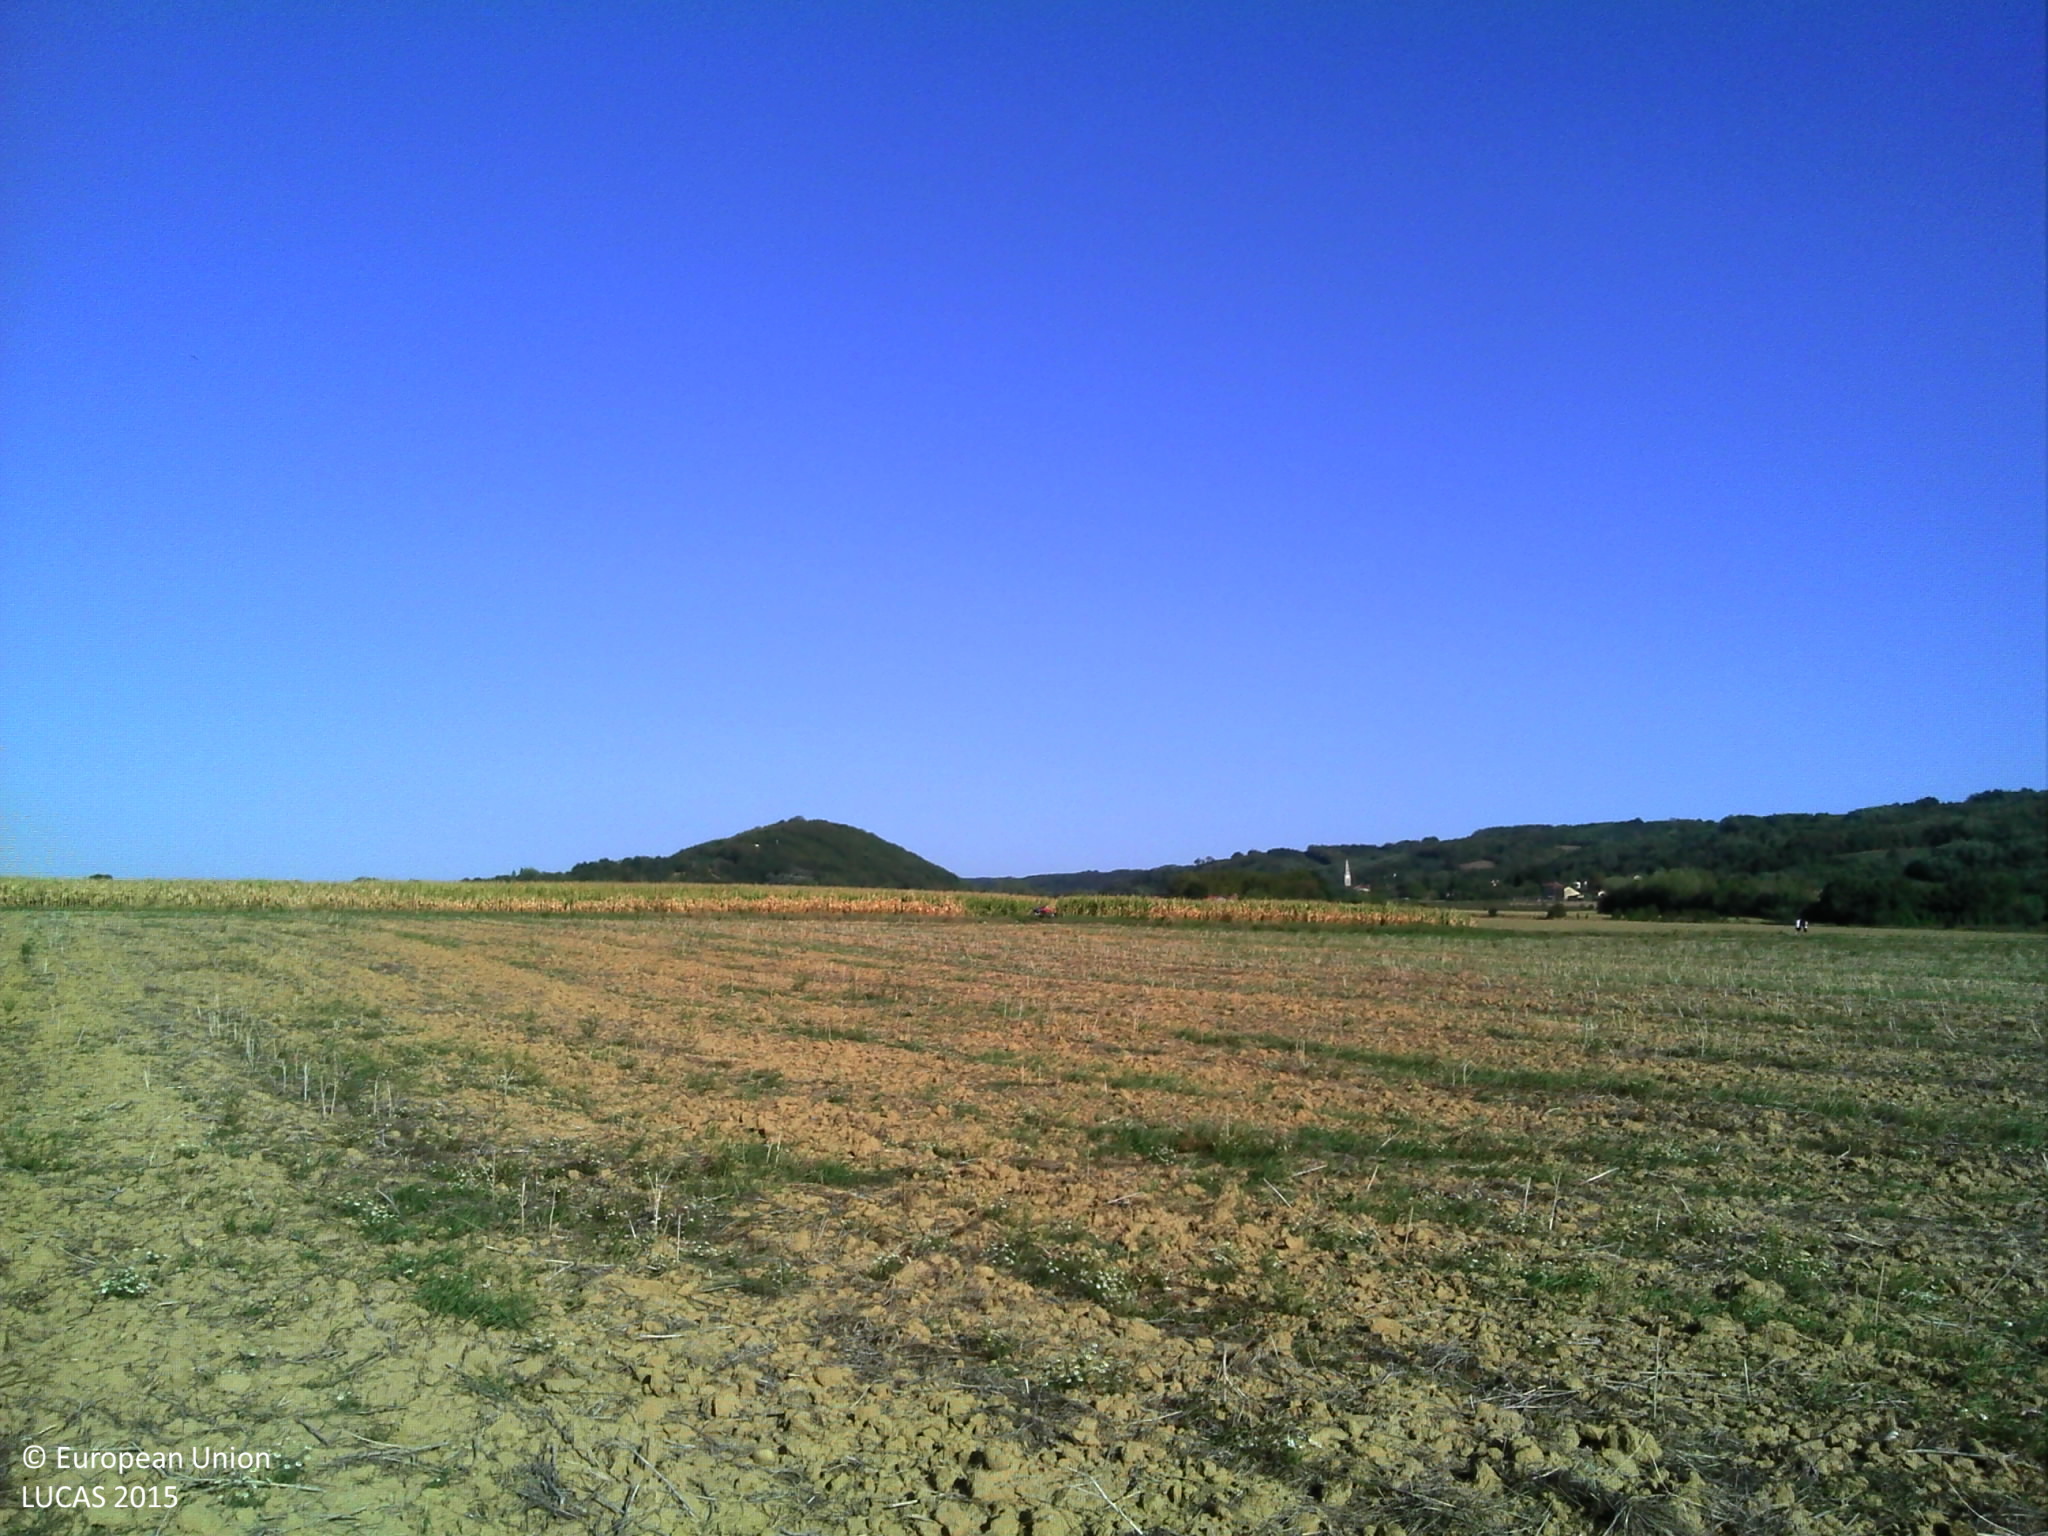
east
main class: Cropland
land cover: Rape and turnip rape
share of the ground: < 10 %
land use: Agriculture (excluding fallow land and kitchen gardens)
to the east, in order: Rape and turnip rape; Tracks; Grass margins; Ditches and canals; Maize
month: September
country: FR
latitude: 45.2966
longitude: 5.0189
